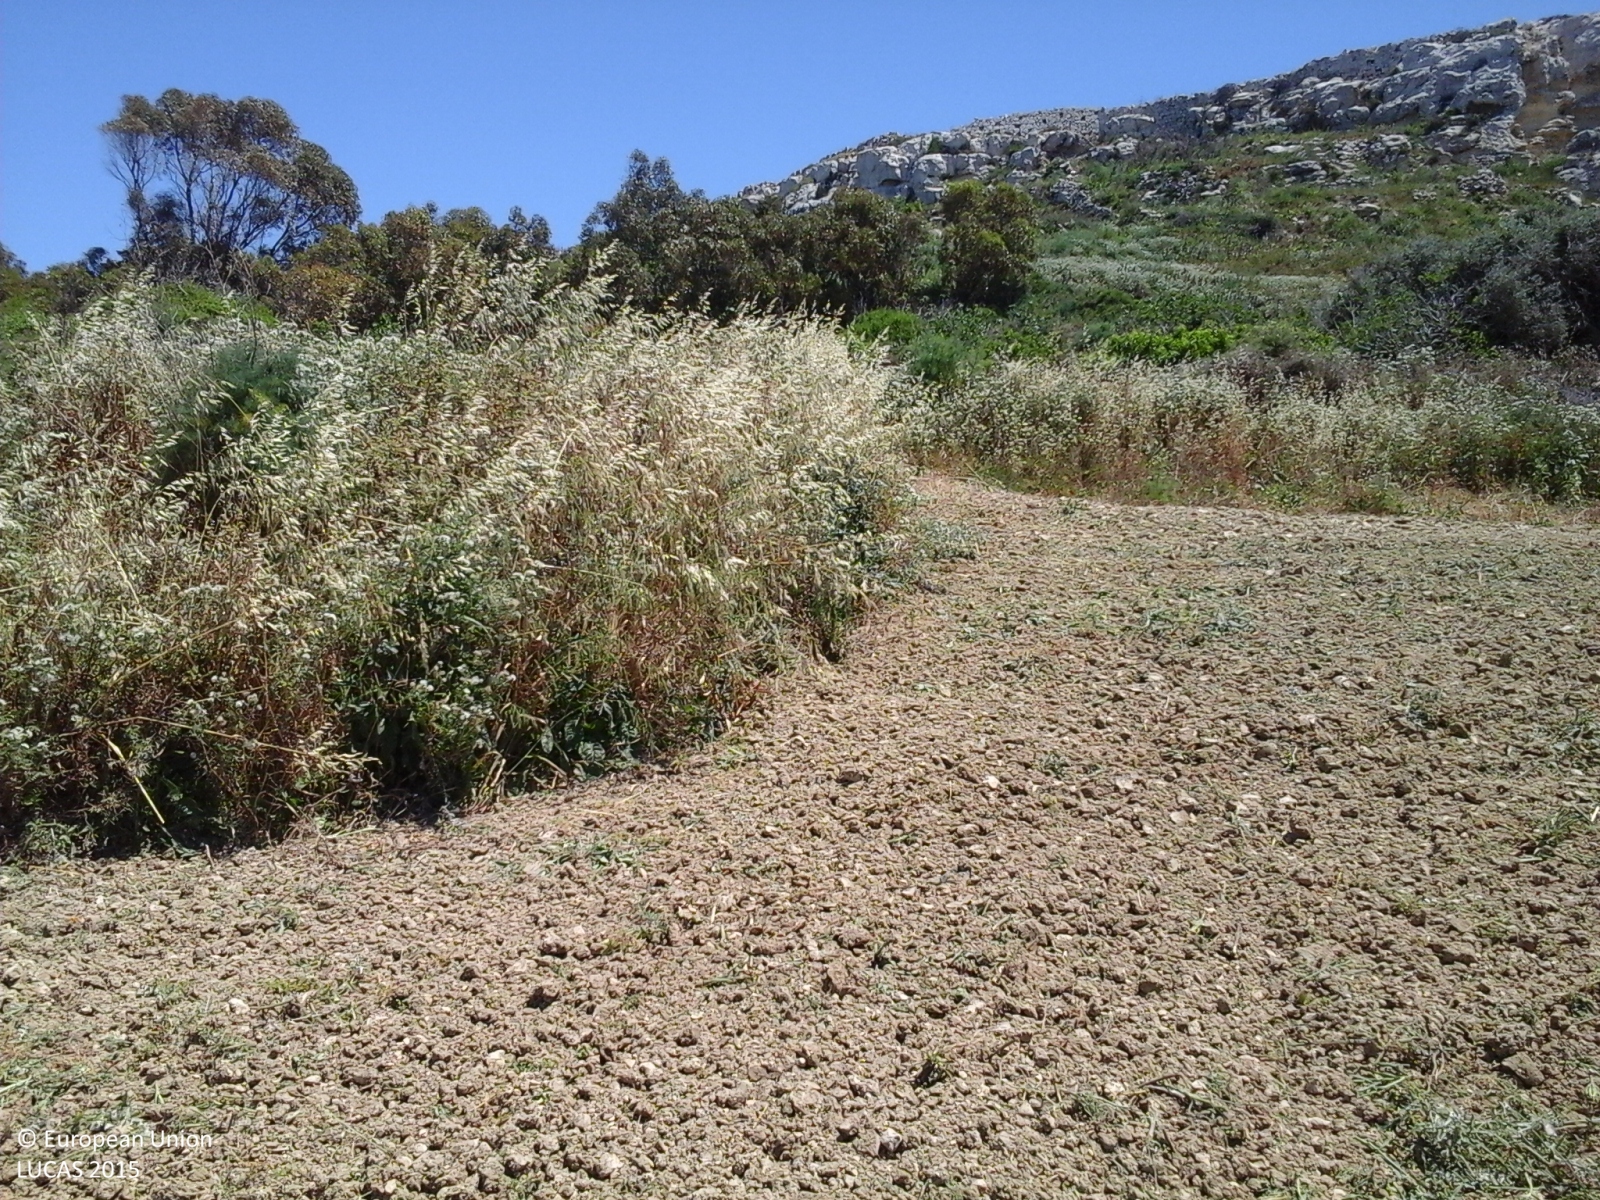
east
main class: Cropland
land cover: Dry pulses
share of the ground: > 75 %
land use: Agriculture (excluding fallow land and kitchen gardens)
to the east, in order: Dry pulses; Grass margins; Dry pulses; Tracks; Dry stone walls; Other fruit trees and berries; Dry stone walls; Other fruit trees and berries; Dry stone walls; Other citrus fruit; Shrubland with sparse tree cover; Dry stone walls; Spontaneously vegetated surfaces; Dry stone walls; Other root crops
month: May
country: MT
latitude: 35.9007
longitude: 14.3582
